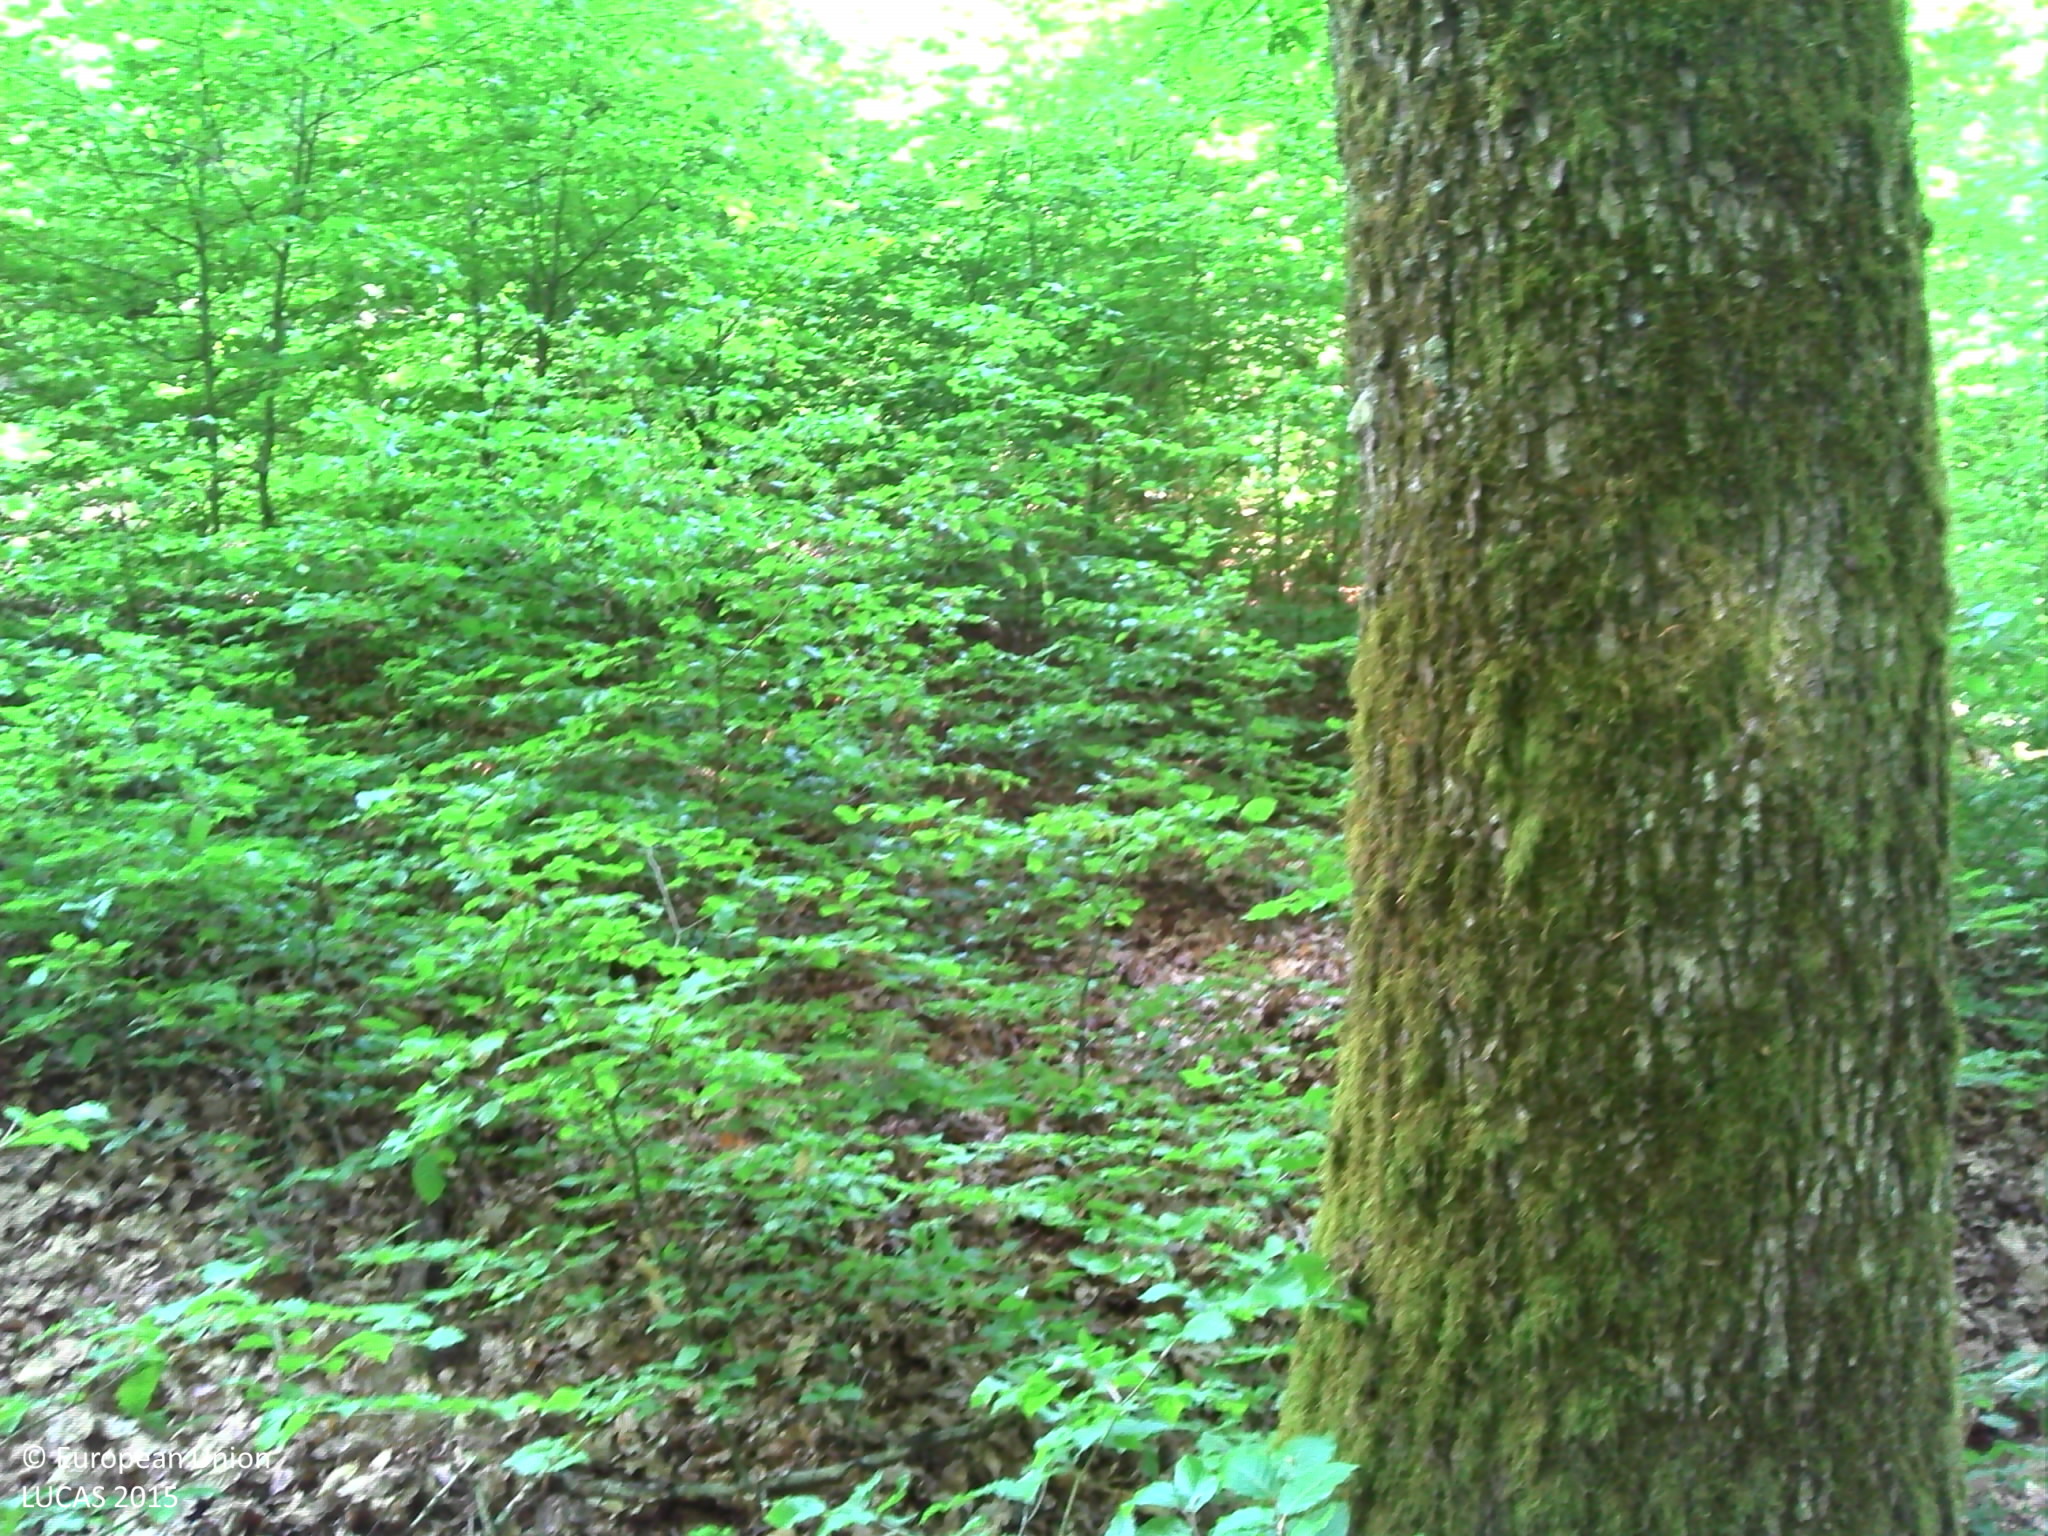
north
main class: Woodland
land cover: Broadleaved woodland
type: acidophilous oak and oak-birch forest
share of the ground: > 75 %
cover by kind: broadleaved forest trees 95 %, coniferous forest trees 5 %
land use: Forestry
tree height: > 5 m
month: May
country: LU
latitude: 49.6967
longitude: 5.9093
